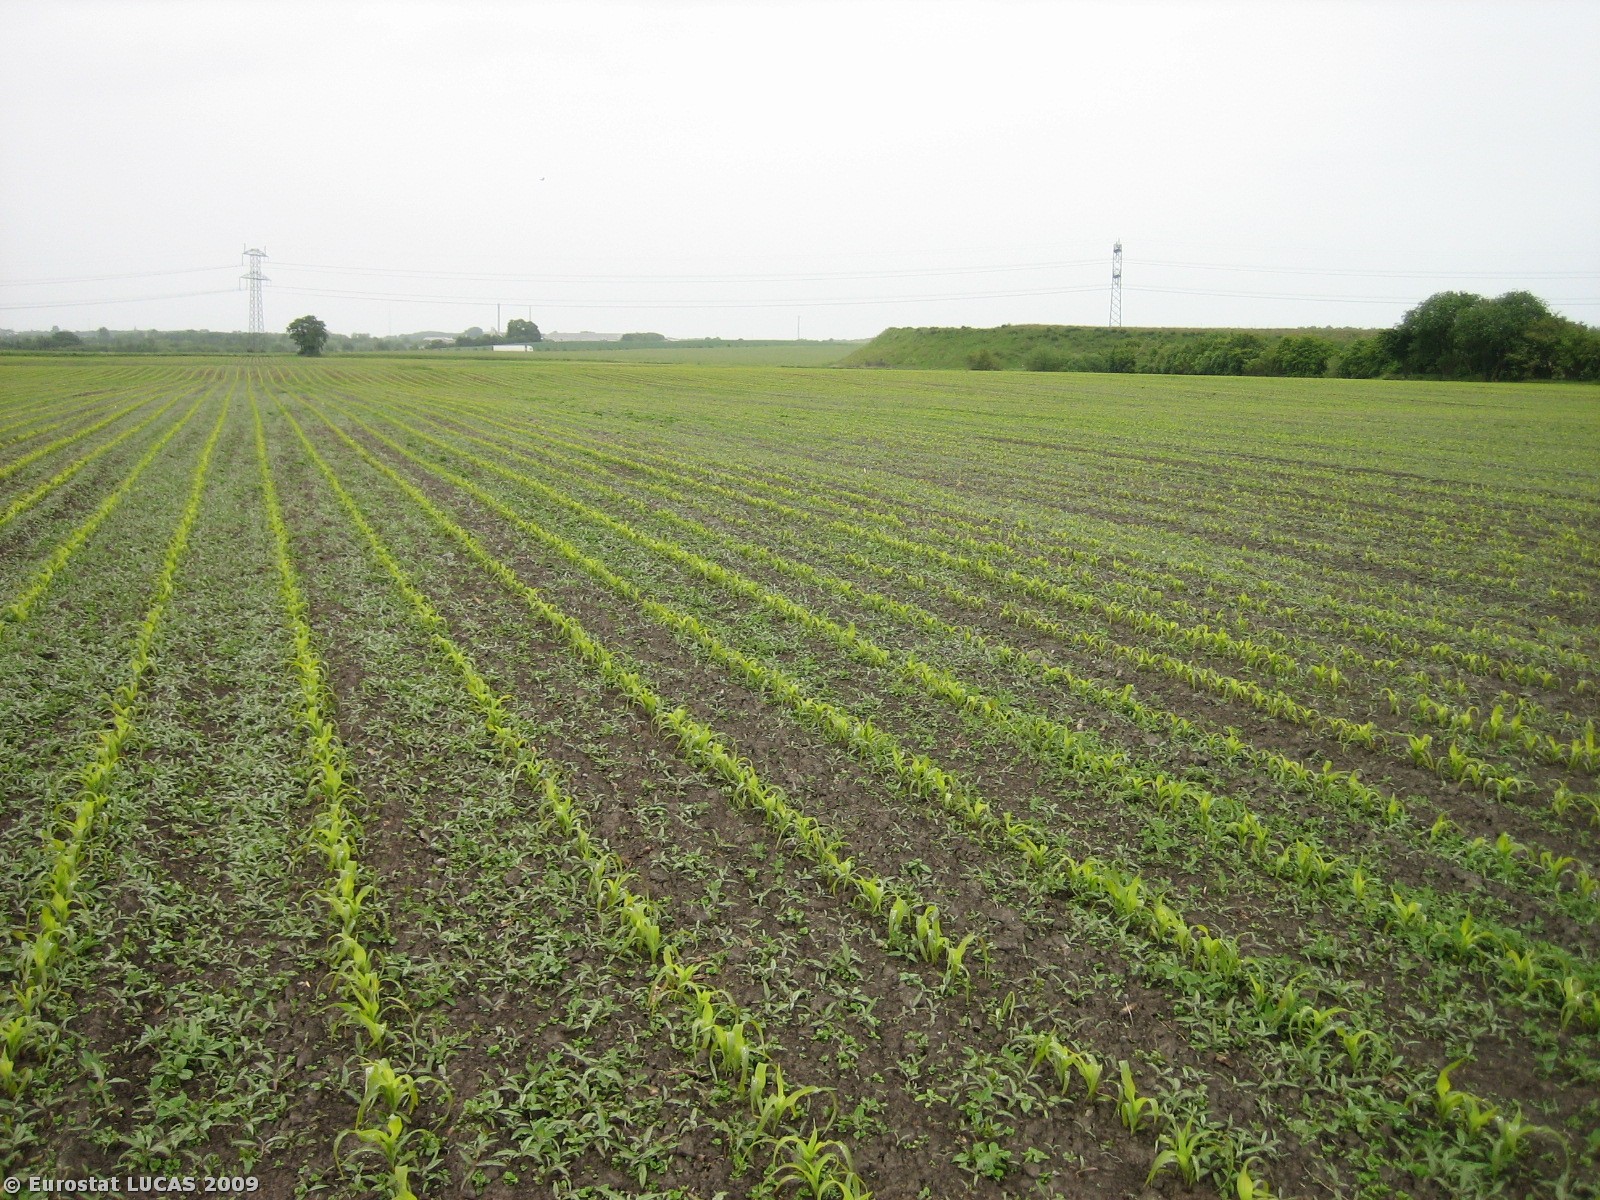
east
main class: Cropland
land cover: Maize
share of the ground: < 10 %
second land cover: Spontaneously vegetated surfaces
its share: 10 - 25 %
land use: Agriculture (excluding fallow land and kitchen gardens)
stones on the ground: < 10 %
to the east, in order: Maize; Spontaneously vegetated surfaces
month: June
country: DK
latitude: 56.2416
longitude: 10.1128
